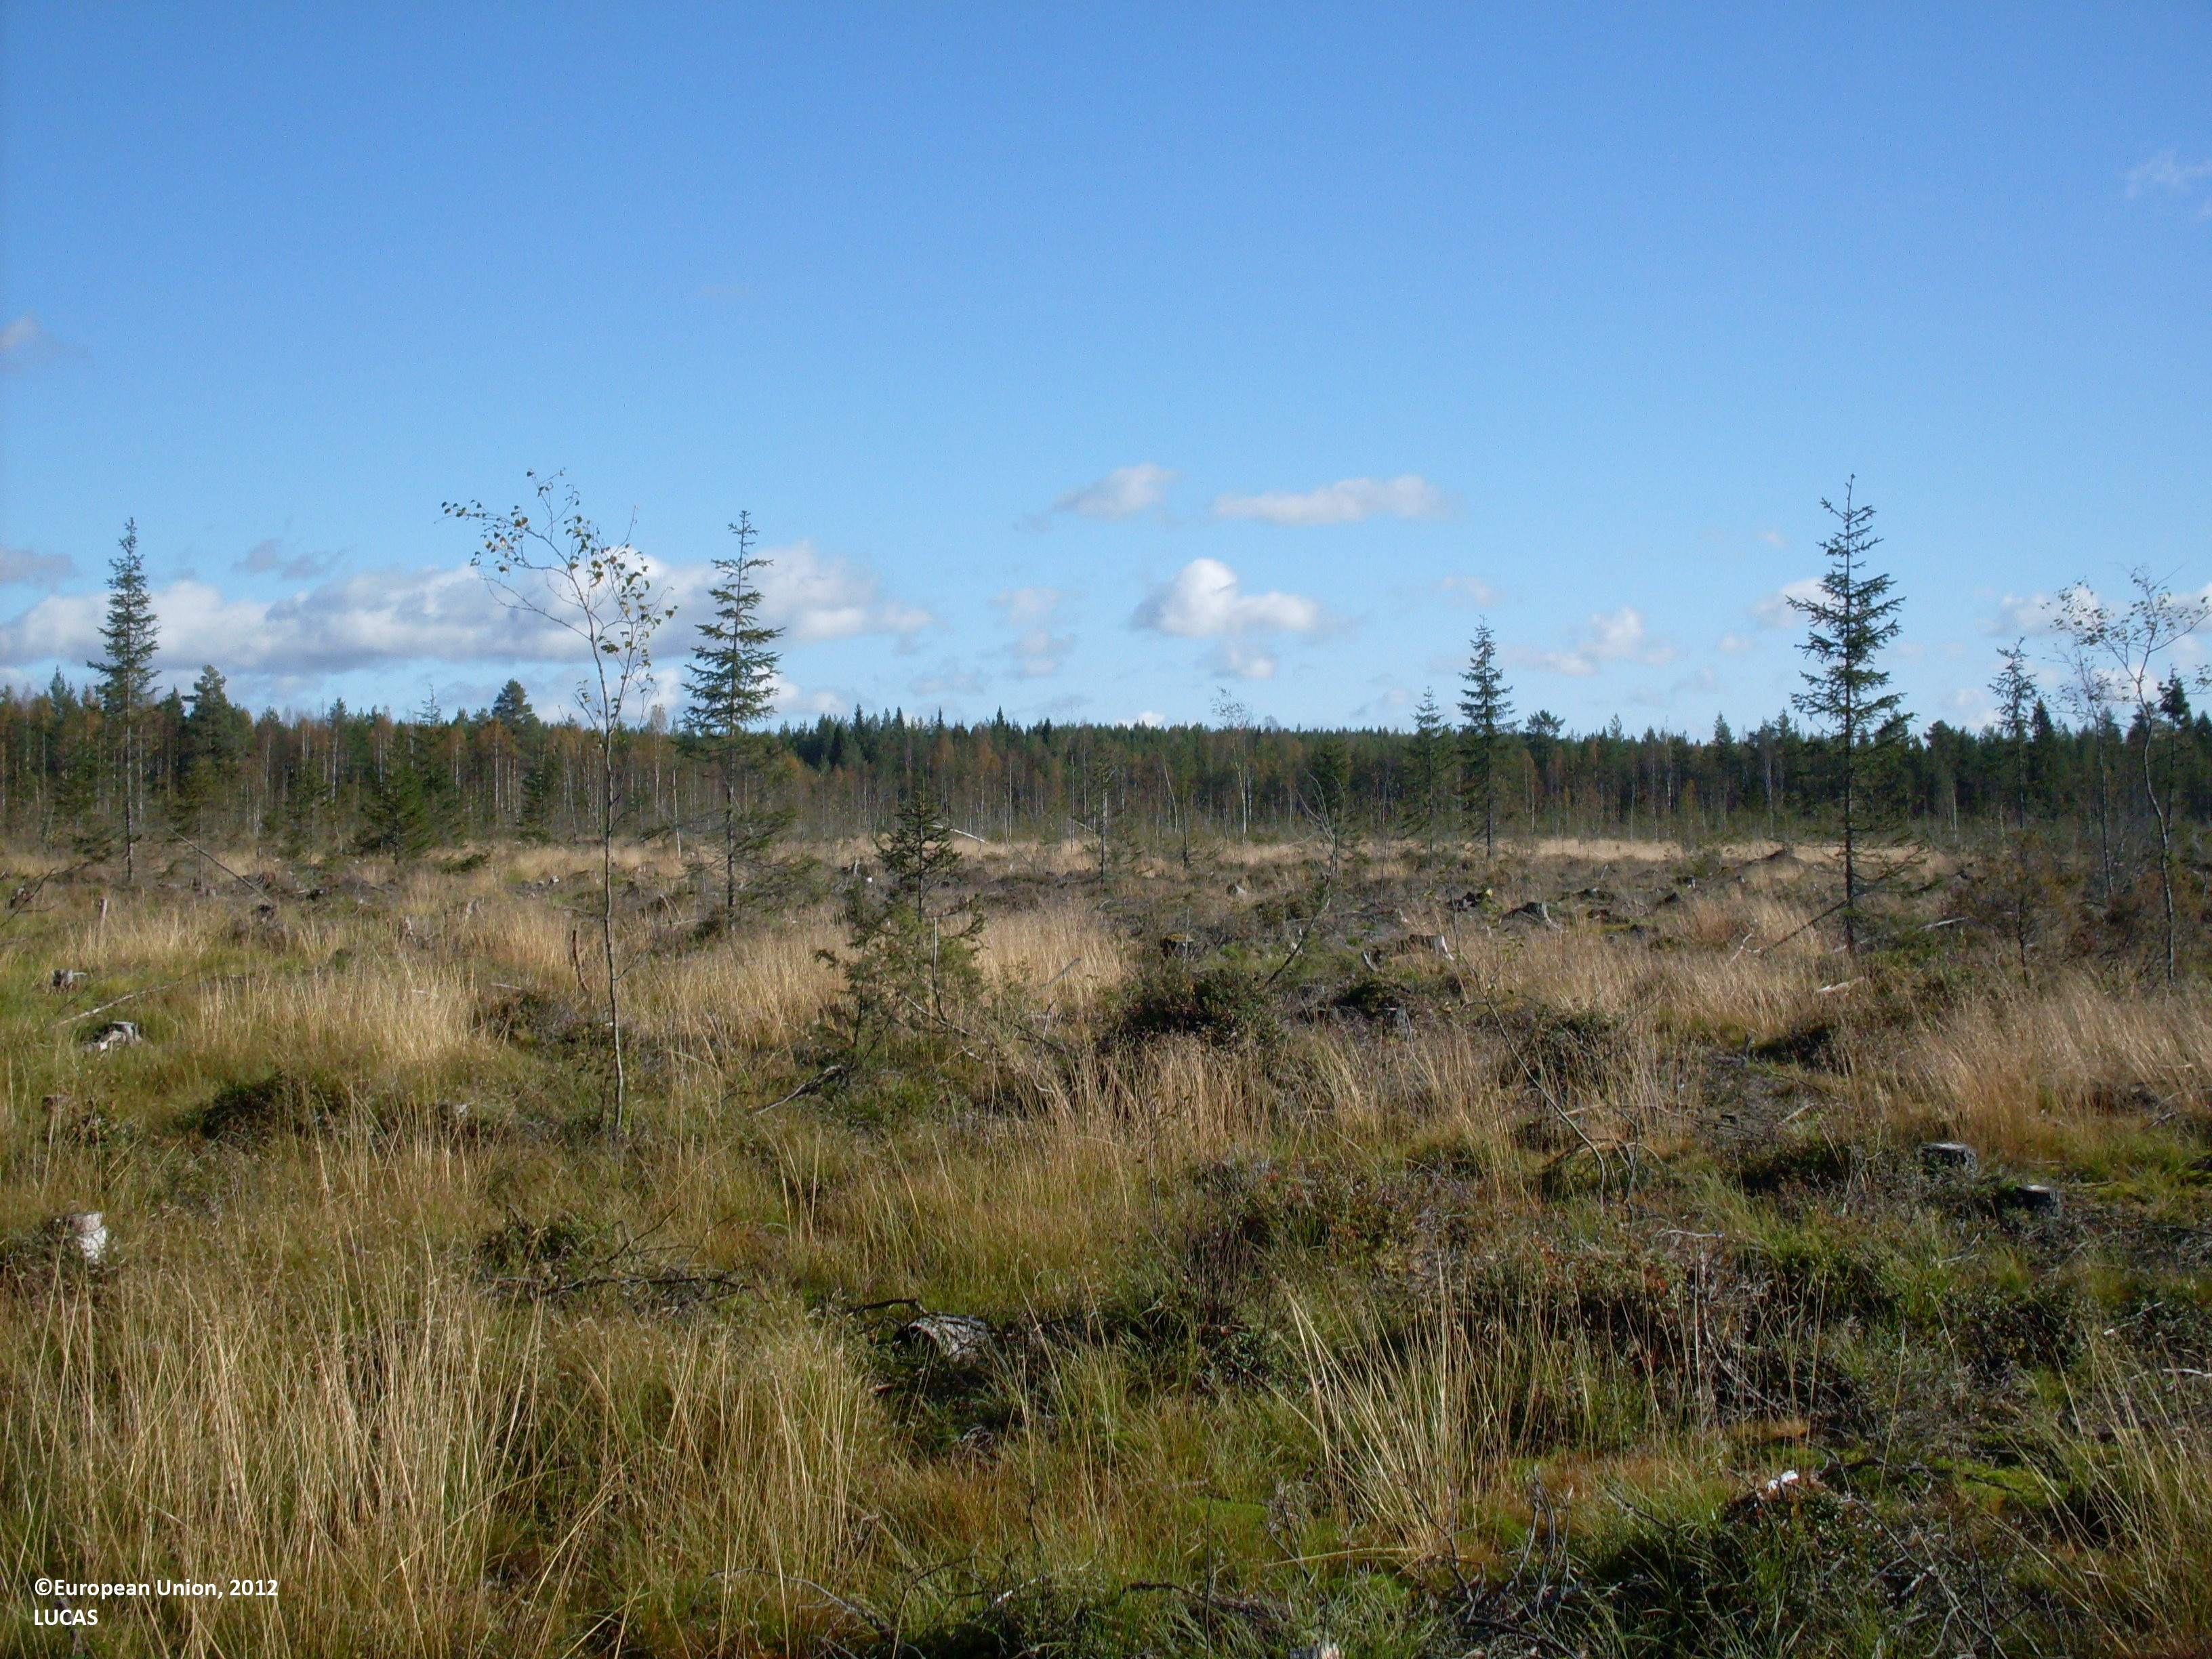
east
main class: Woodland
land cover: Pine dominated mixed woodland
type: boreal forest
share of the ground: 50 - 75 %
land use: Forestry
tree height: > 5 m
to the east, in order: Pine dominated mixed woodland; Shrubland with sparse tree cover; Pine dominated mixed woodland; Ditches and canals; Pine dominated mixed woodland
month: September
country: FI
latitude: 64.3059
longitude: 28.4725
